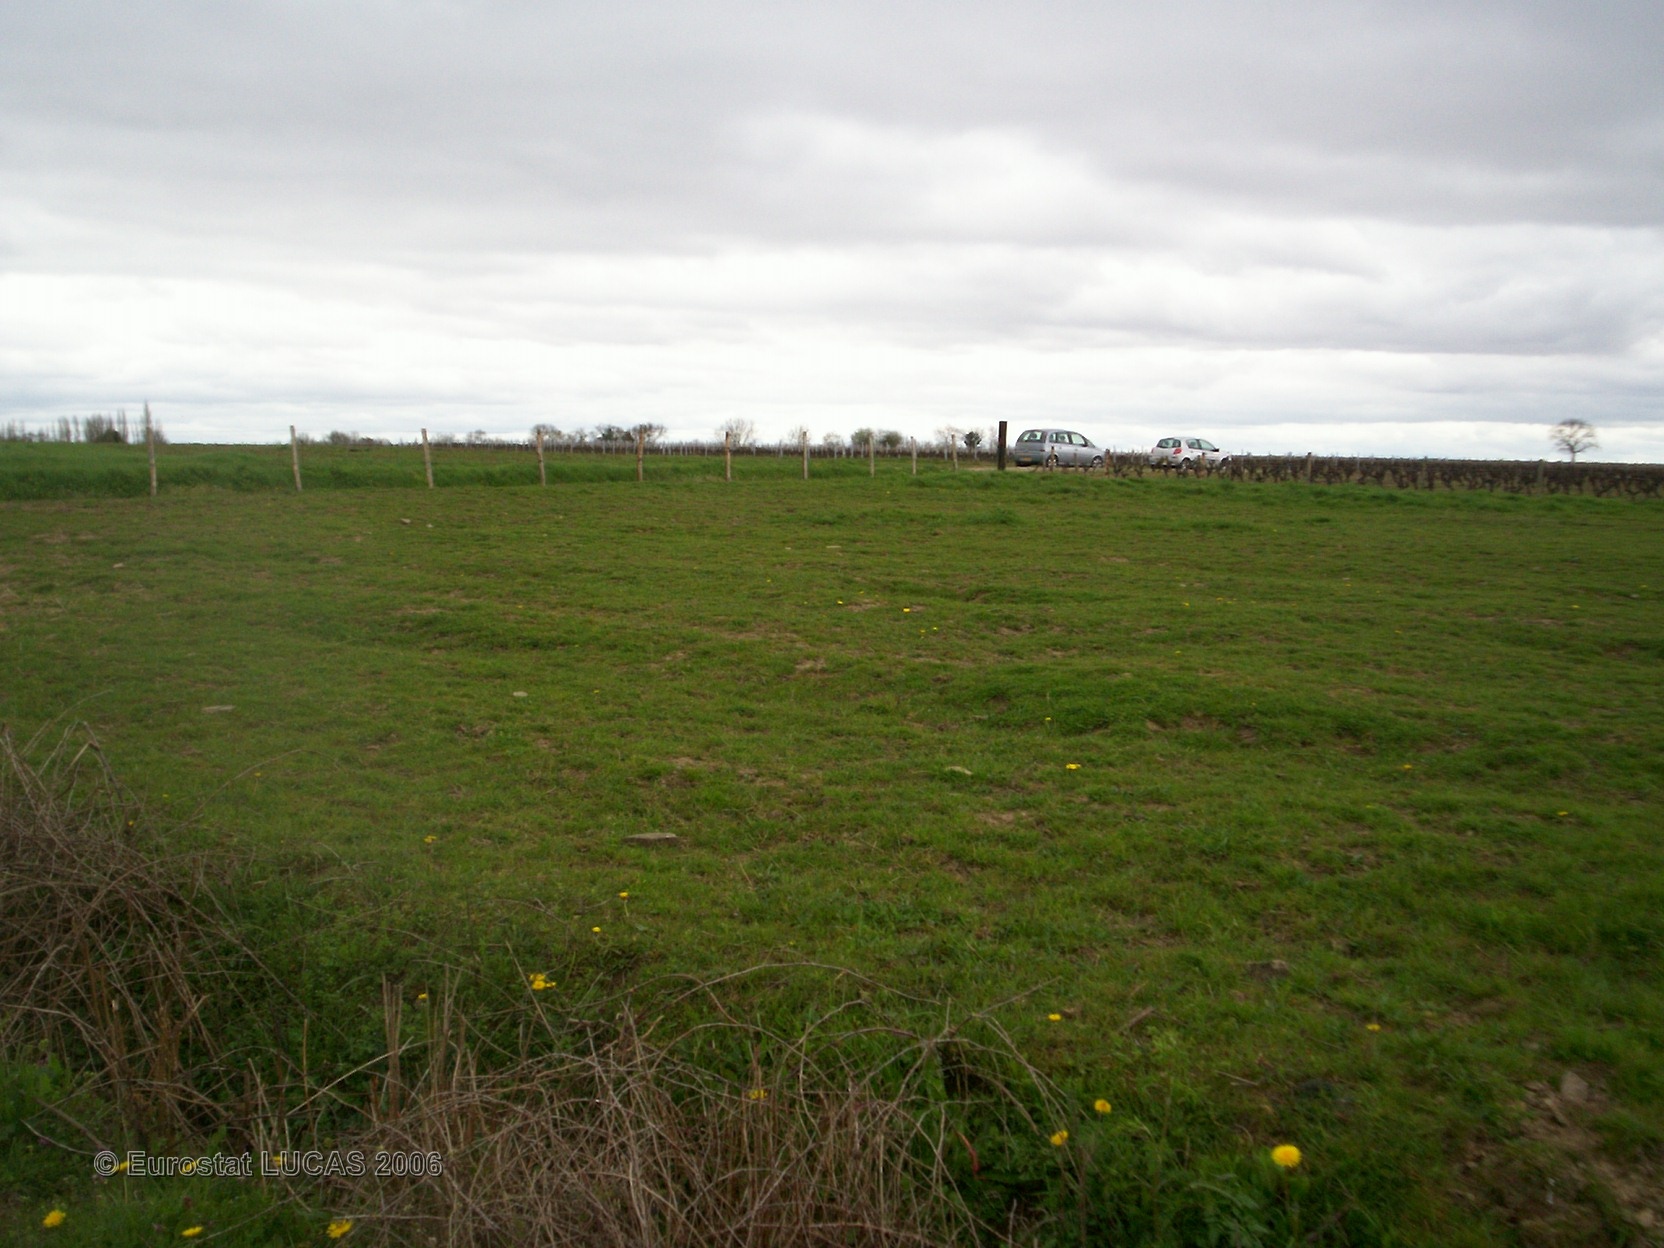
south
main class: Grassland
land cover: Grassland without tree/shrub cover
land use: Agriculture (excluding fallow land and kitchen gardens)
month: April
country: FR
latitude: 47.2550
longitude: -1.3376
